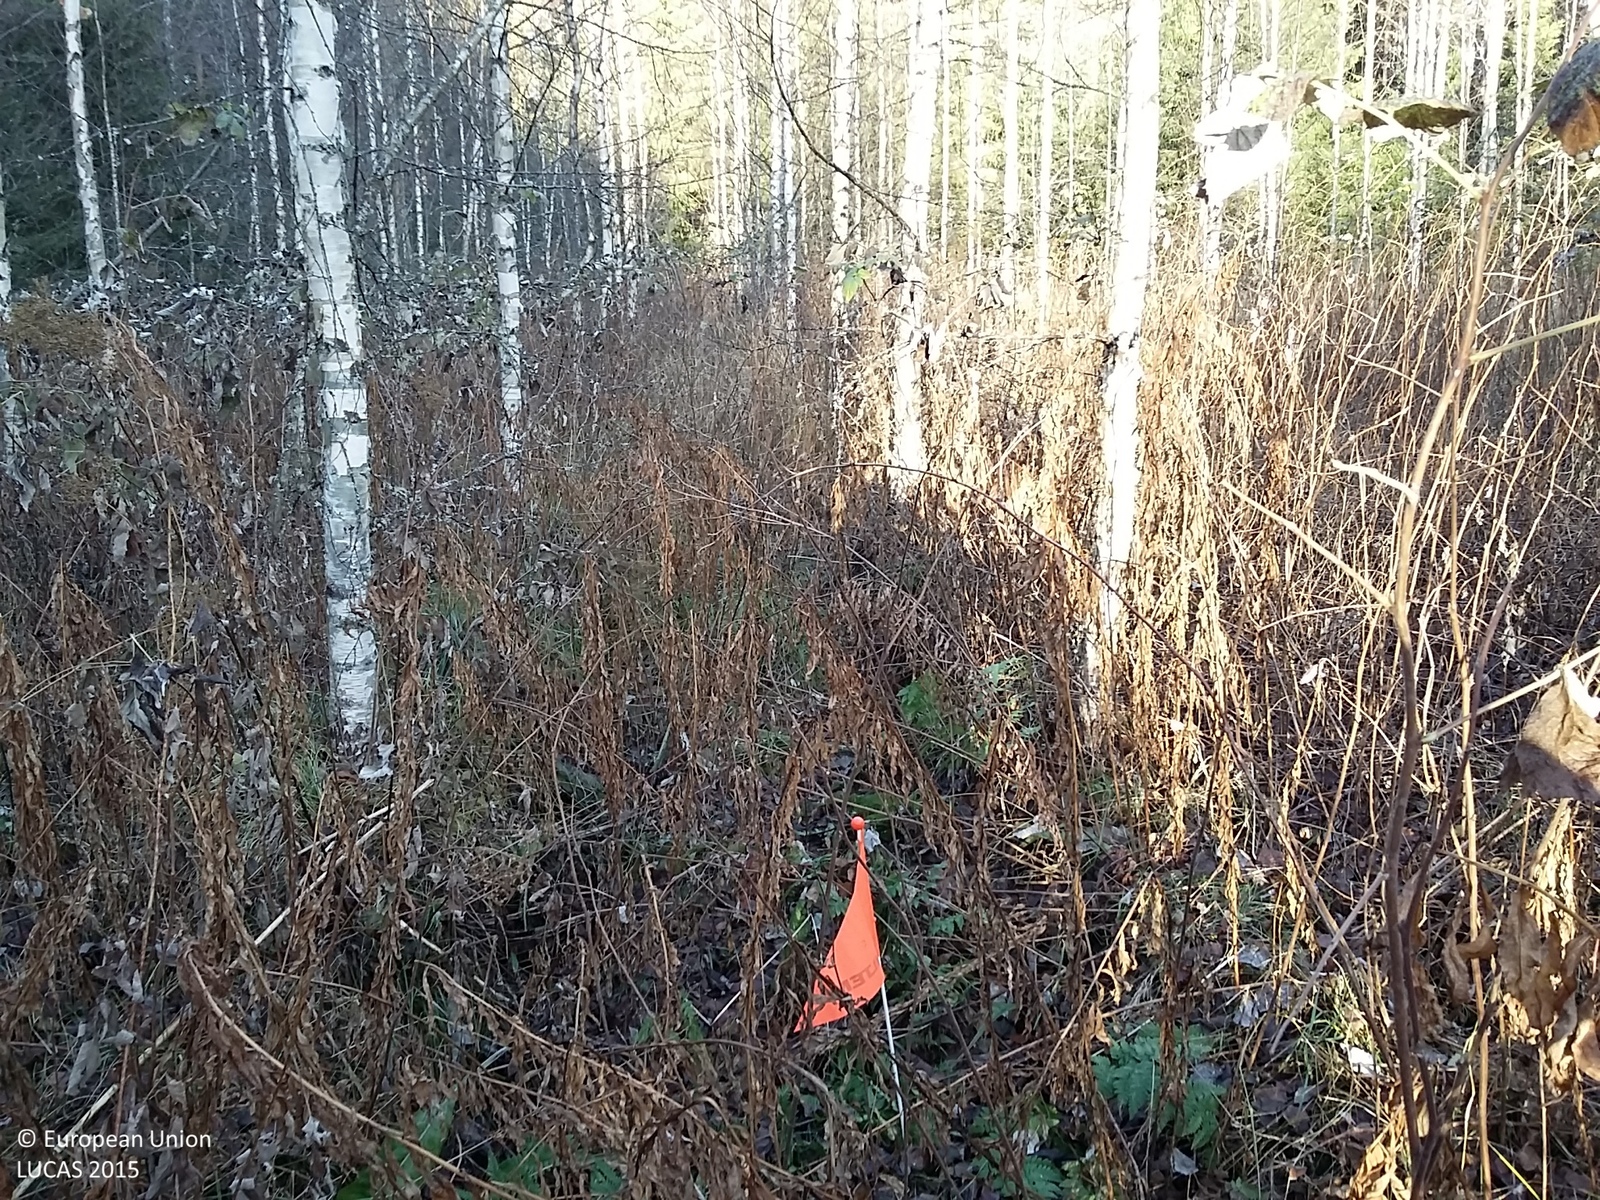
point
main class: Woodland
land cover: Broadleaved woodland
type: non-riverine alder, birch or aspen forest
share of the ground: 50 - 75 %
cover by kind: broadleaved forest trees 70 %, shrubs 15 %, herbaceous plants 15 %
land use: Forestry
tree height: > 5 m
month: October
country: FI
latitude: 64.5498
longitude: 25.5450
